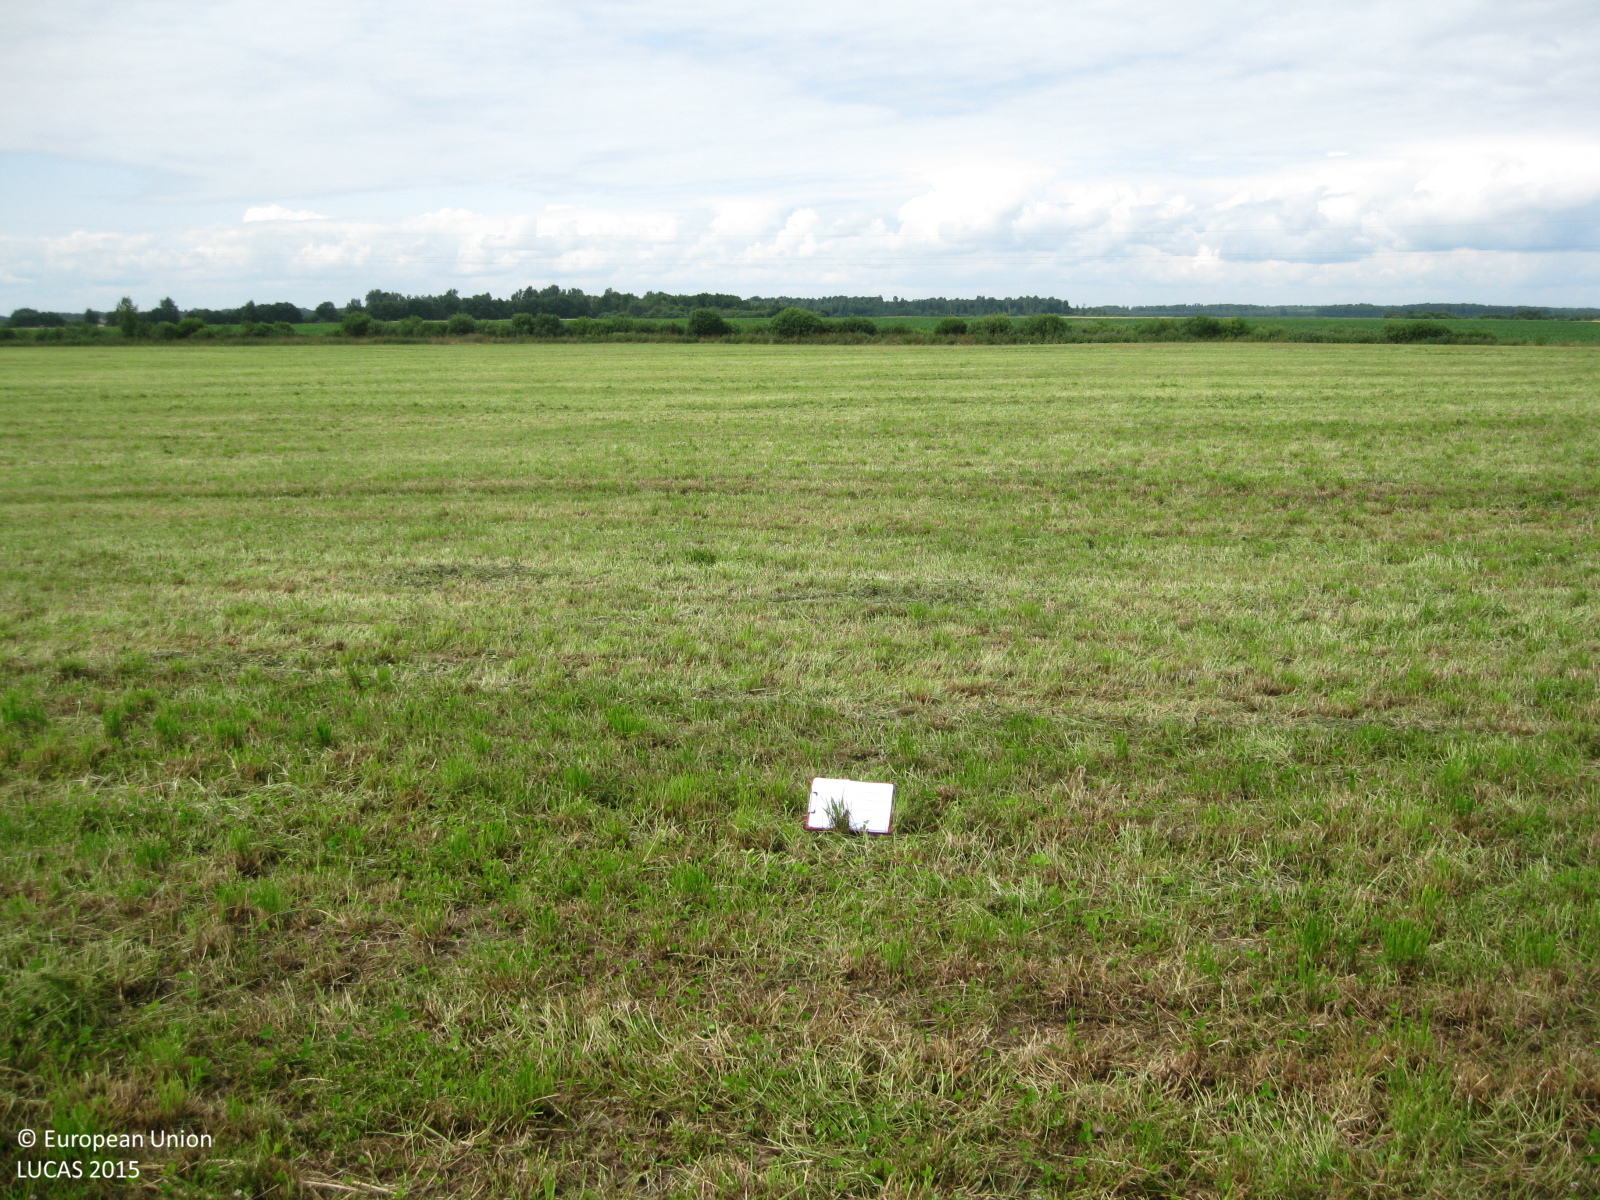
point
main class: Grassland
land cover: Grassland without tree/shrub cover
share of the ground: > 75 %
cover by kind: herbaceous plants 100 %
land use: Agriculture (excluding fallow land and kitchen gardens)
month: July
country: LT
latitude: 55.5924
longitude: 24.6867
